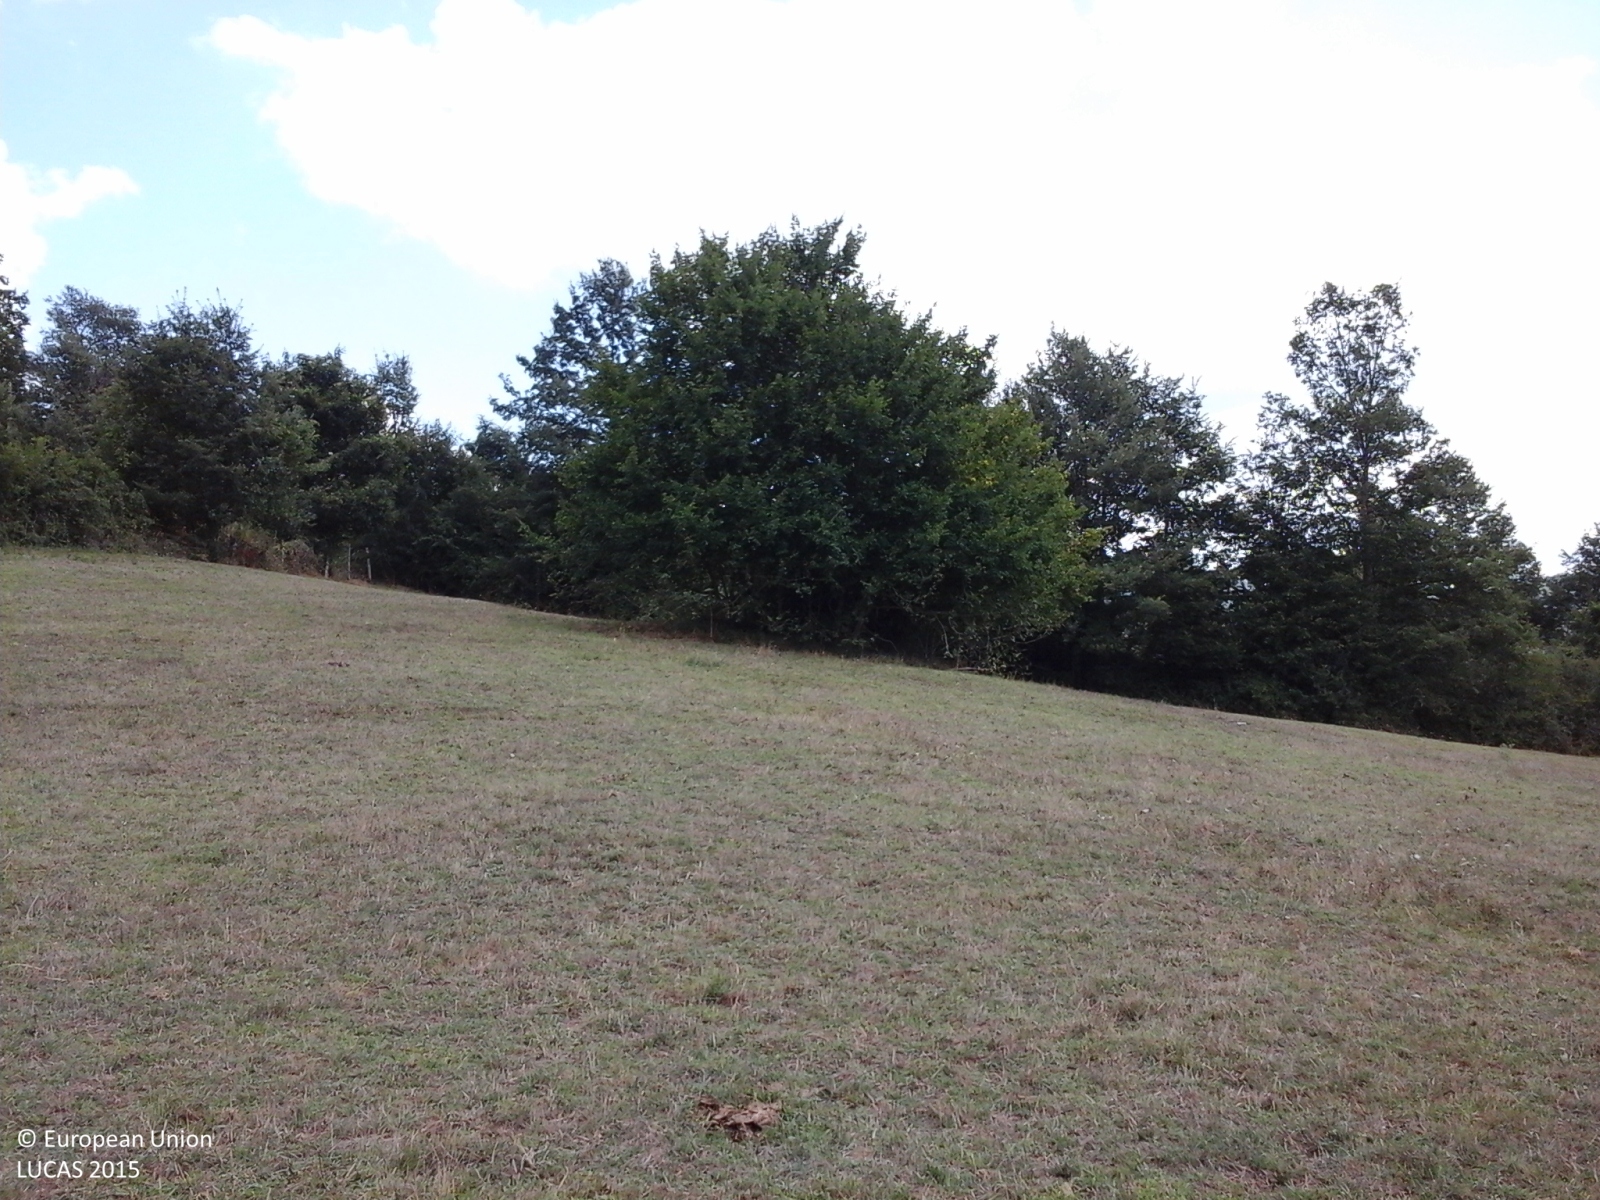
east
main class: Grassland
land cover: Grassland without tree/shrub cover
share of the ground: > 75 %
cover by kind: herbaceous plants 100 %
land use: Agriculture (excluding fallow land and kitchen gardens)
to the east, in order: Grassland without tree/shrub cover; Single bushes/trees; Grassland without tree/shrub cover; Broadleaved woodland; Grassland without tree/shrub cover; Broadleaved woodland; Grassland without tree/shrub cover
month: August
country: IT
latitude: 41.7707
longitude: 14.2079
